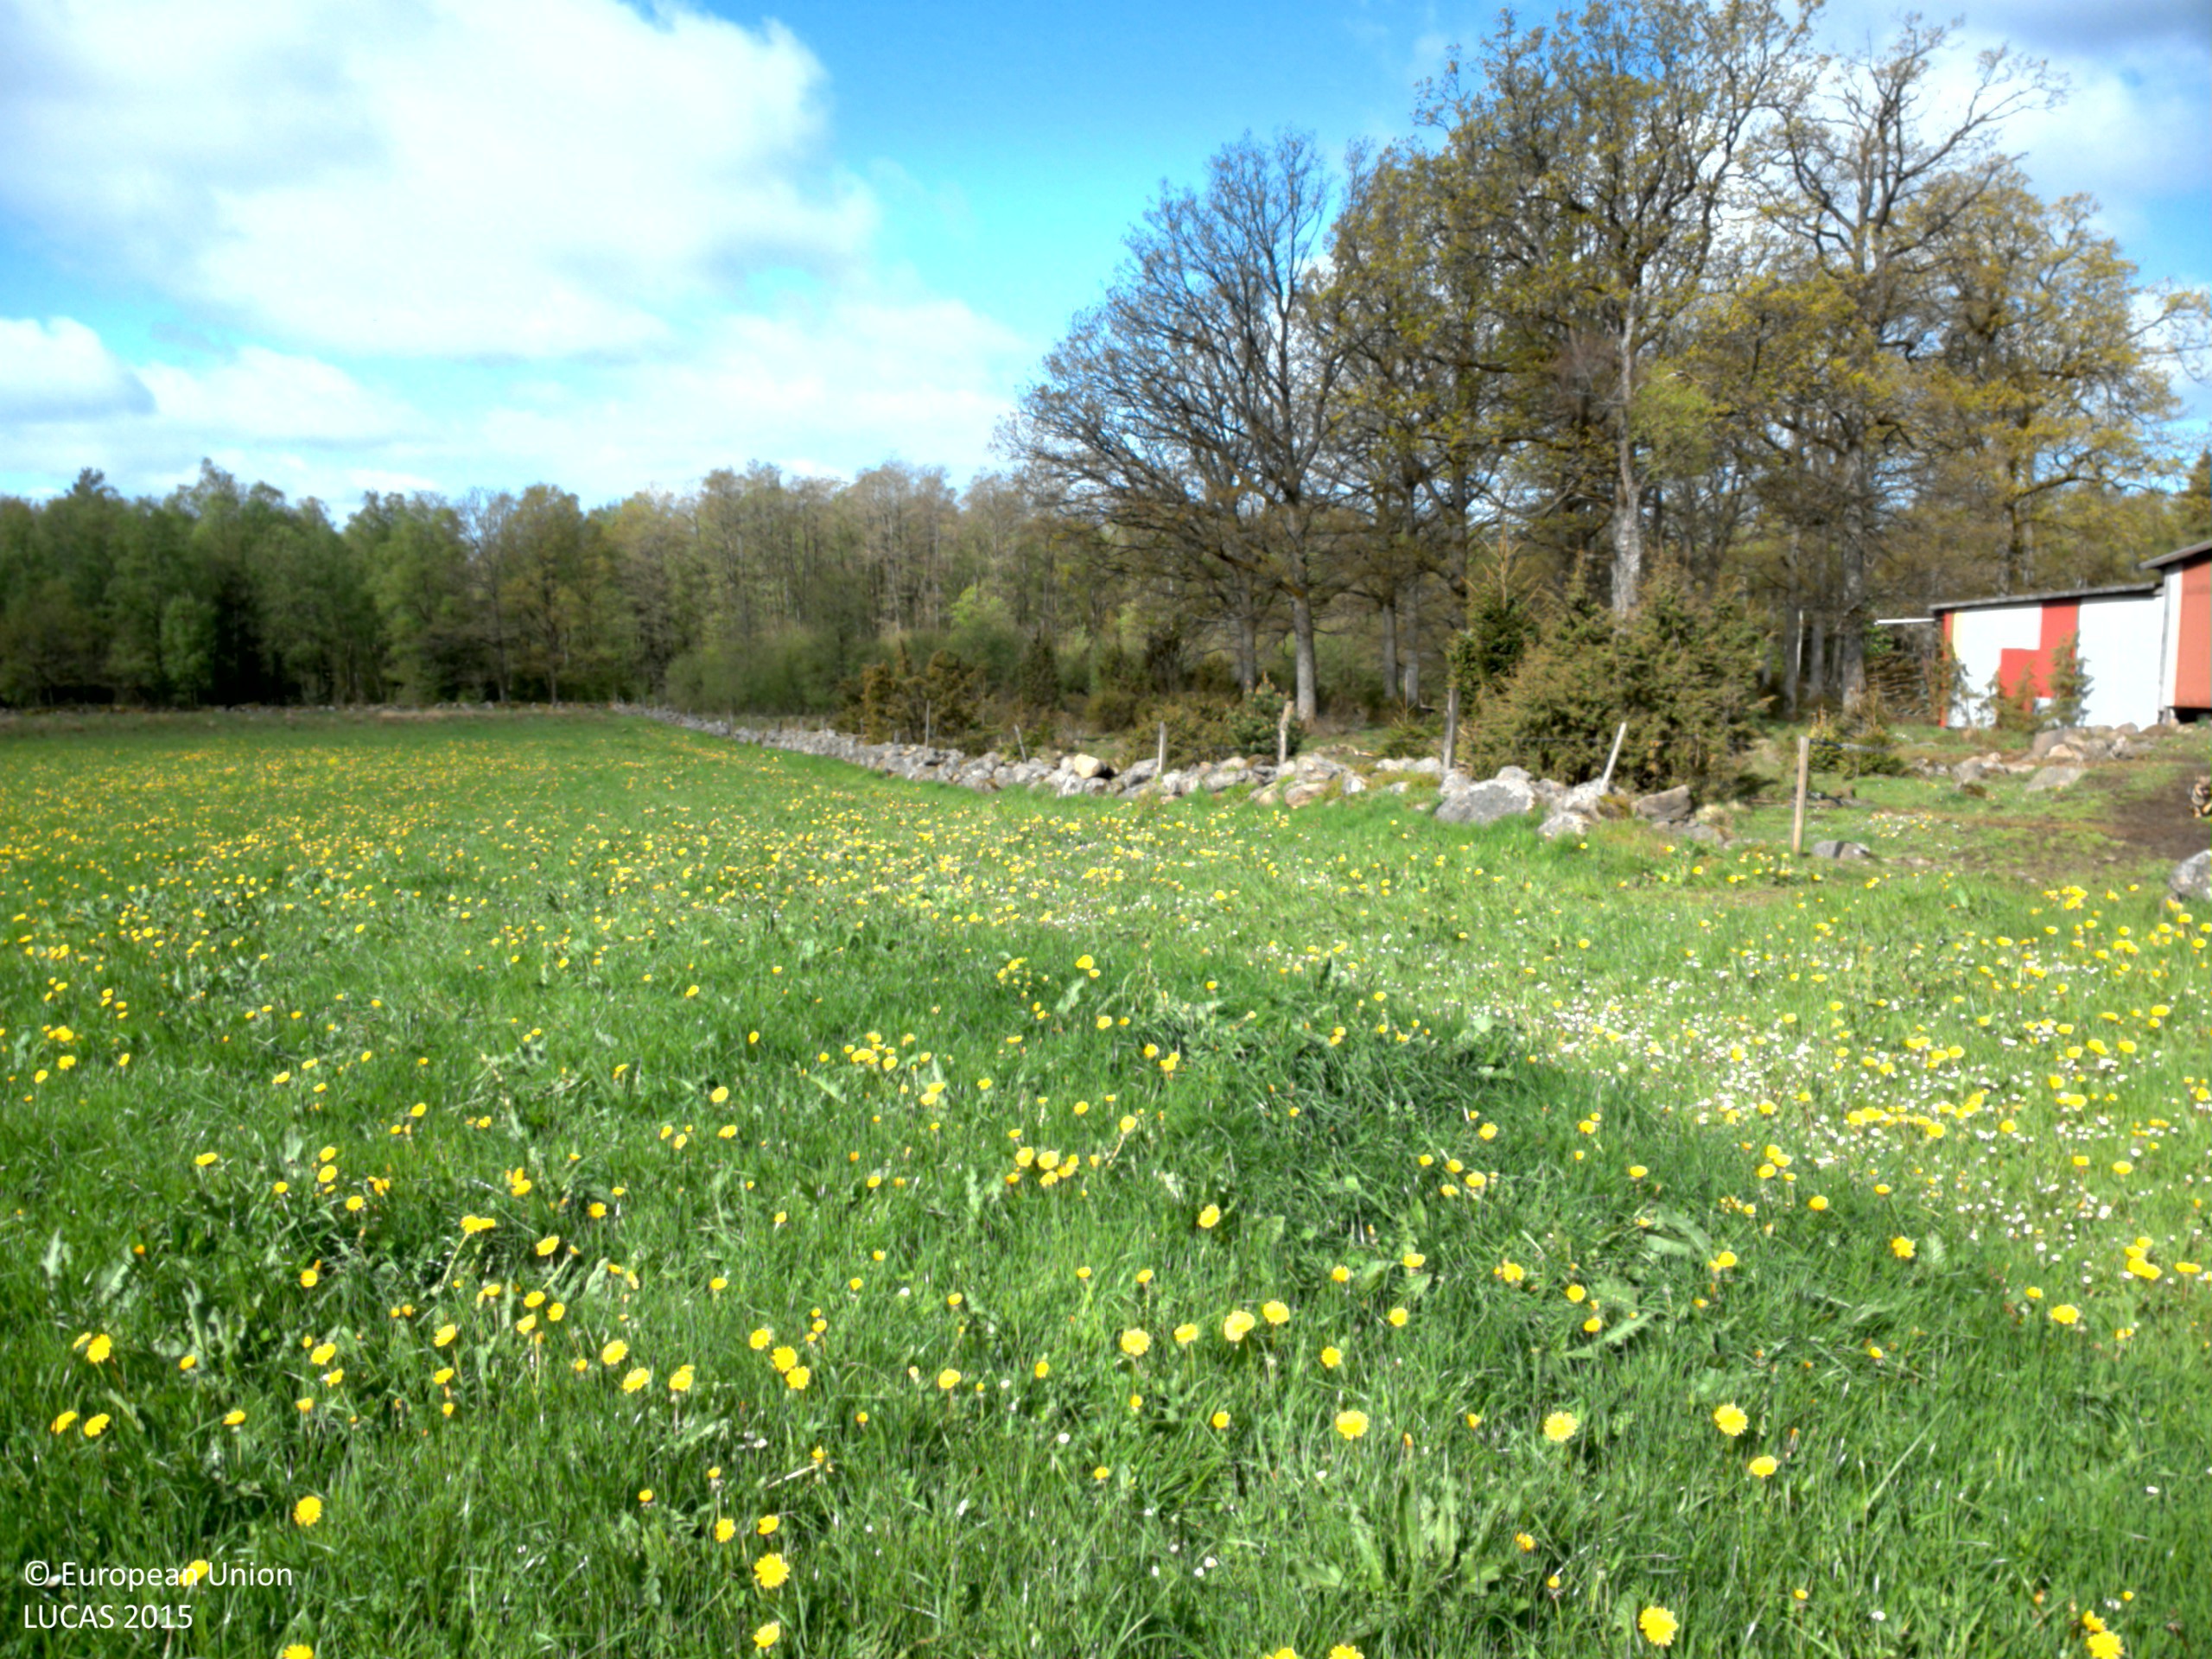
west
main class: Grassland
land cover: Grassland without tree/shrub cover
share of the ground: > 75 %
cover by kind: herbaceous plants 100 %
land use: Agriculture (excluding fallow land and kitchen gardens)
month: May
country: SE
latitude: 57.8431
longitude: 13.0444
